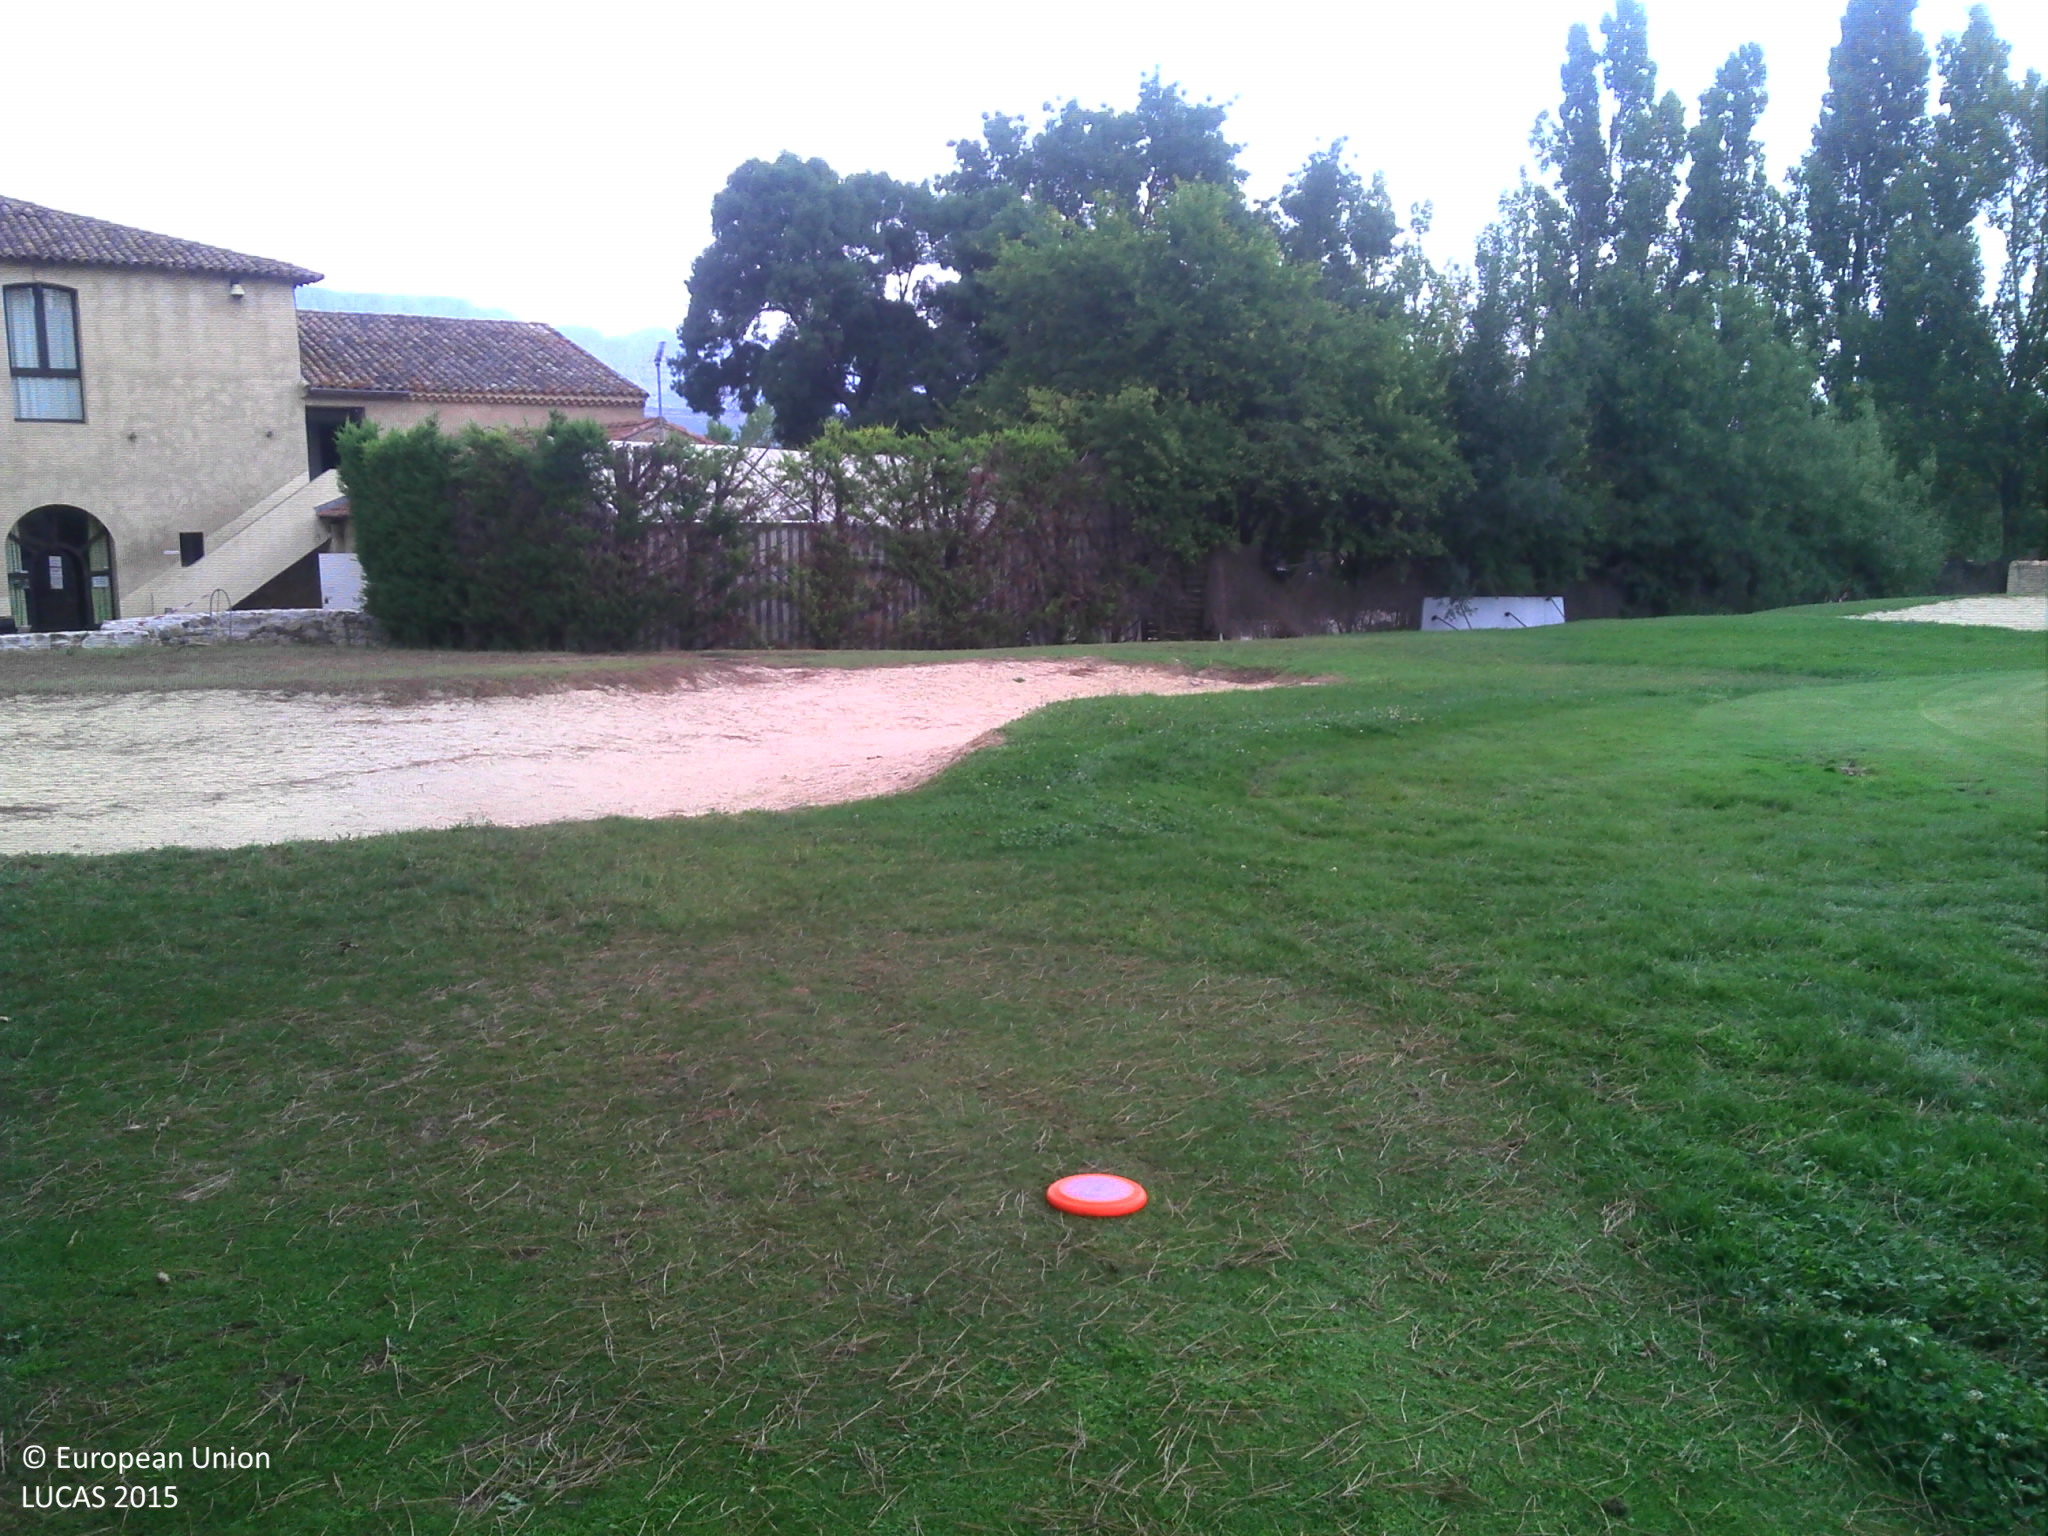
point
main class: Grassland
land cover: Grassland with sparse tree/shrub cover
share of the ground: > 75 %
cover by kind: herbaceous plants 85 %, unconsolidated bare surface 10 %, broadleaved forest trees 5 %
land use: Sport
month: August
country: FR
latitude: 43.4622
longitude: 5.5973
